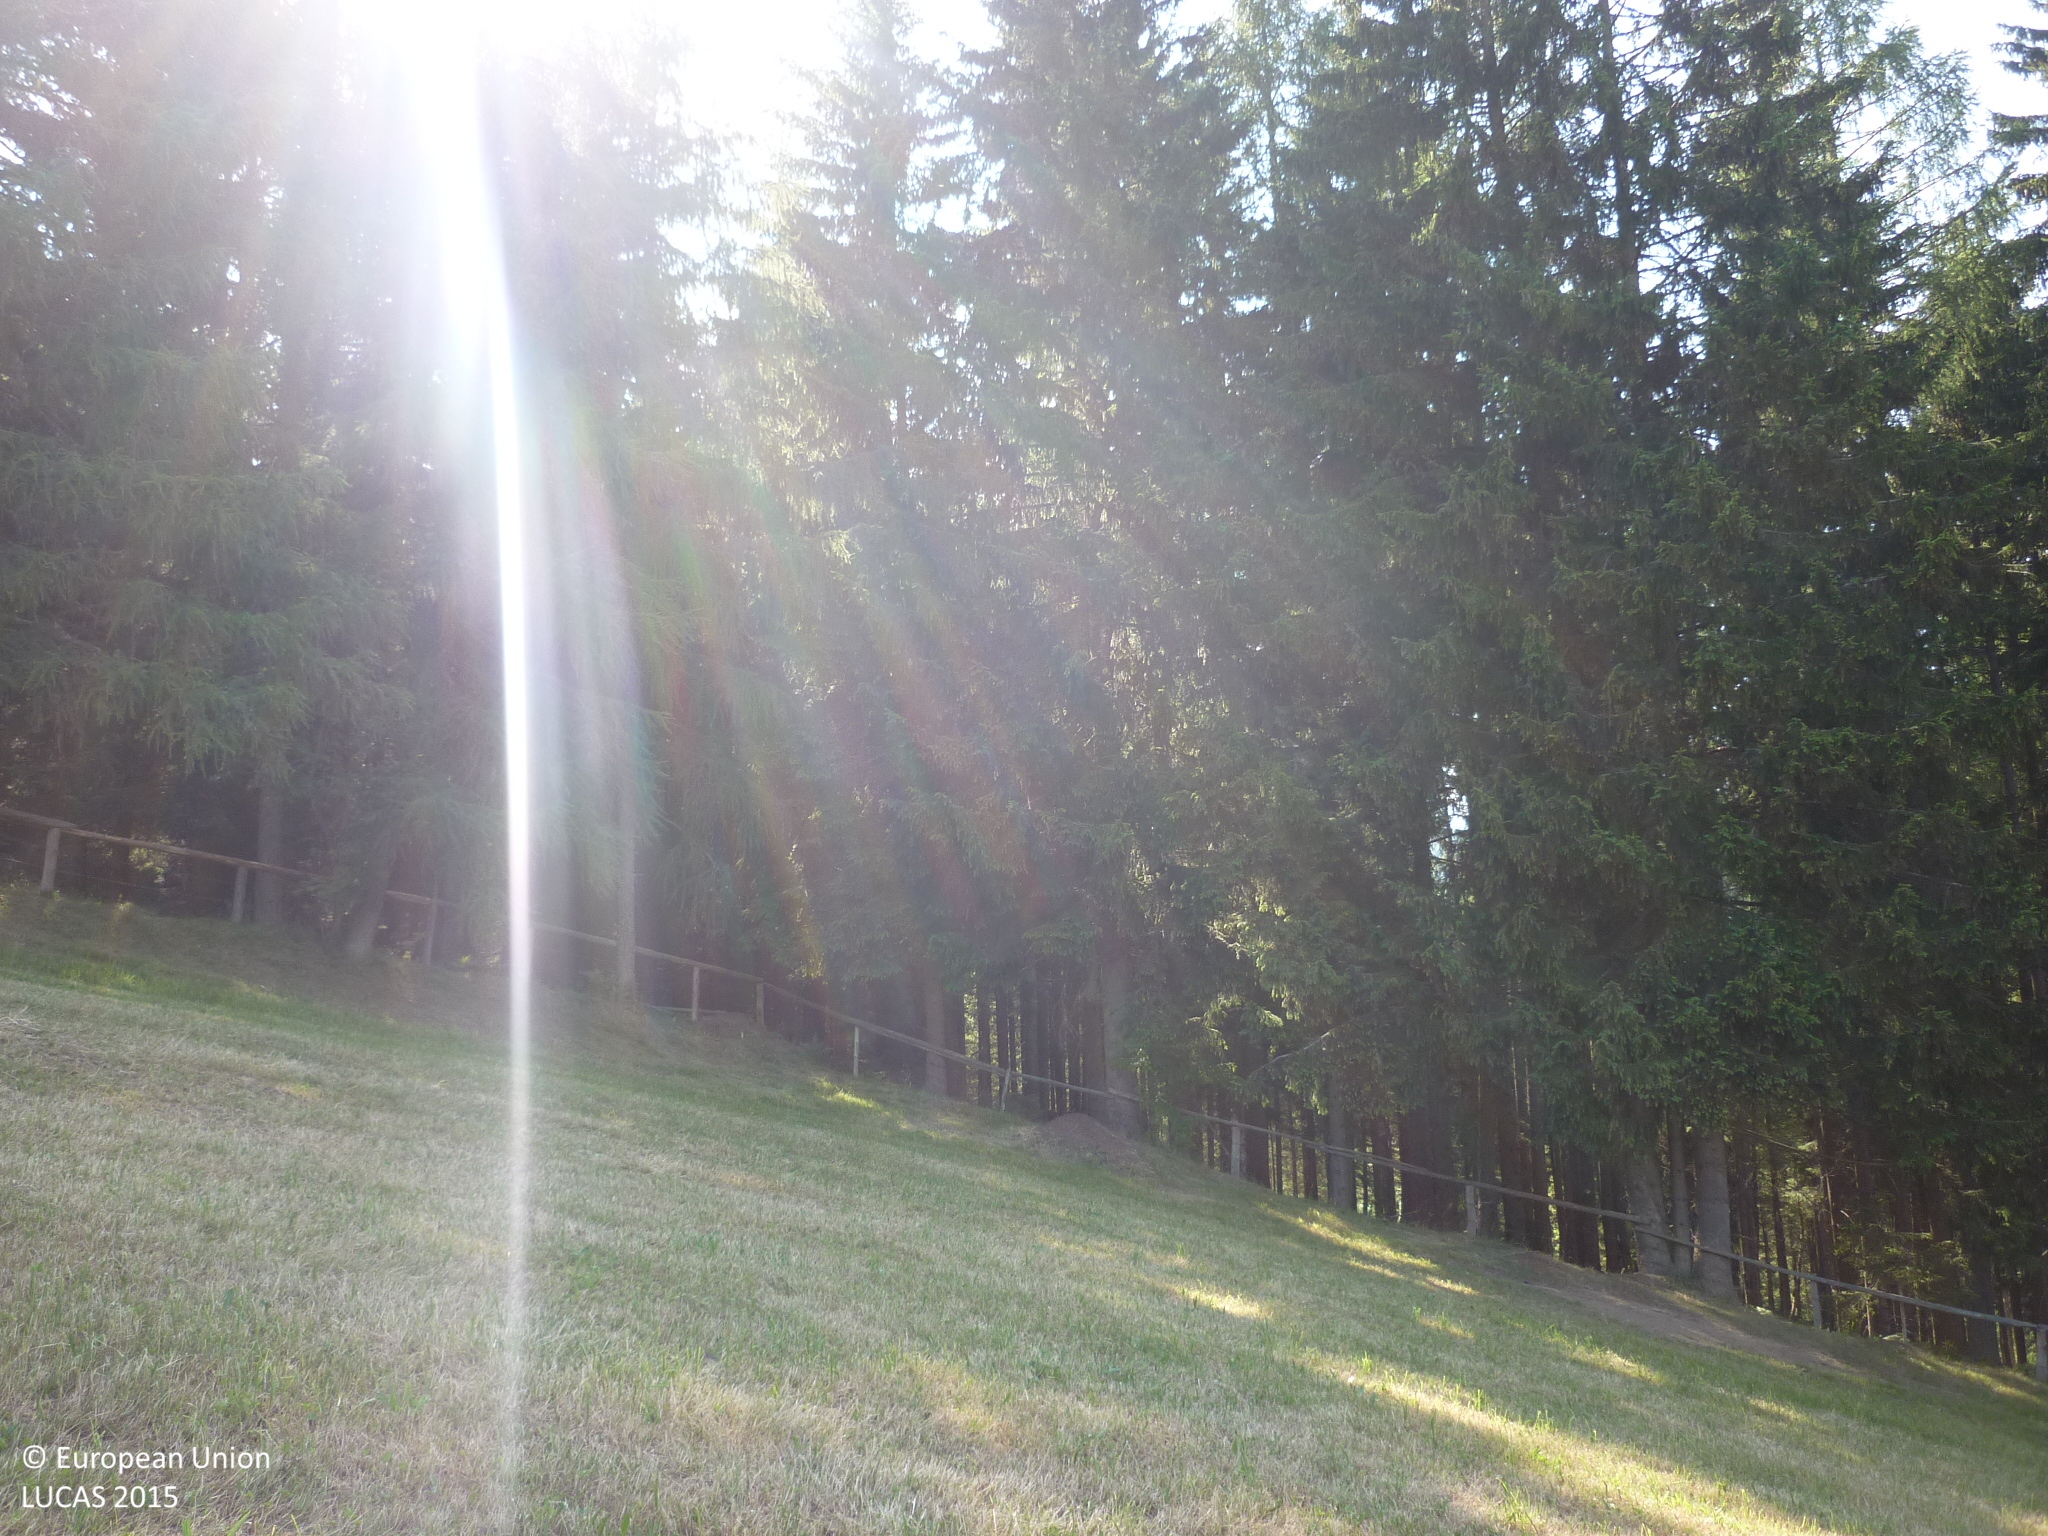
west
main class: Grassland
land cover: Grassland without tree/shrub cover
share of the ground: > 75 %
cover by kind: herbaceous plants 100 %
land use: Agriculture (excluding fallow land and kitchen gardens)
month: July
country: AT
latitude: 47.1170
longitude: 14.6248
